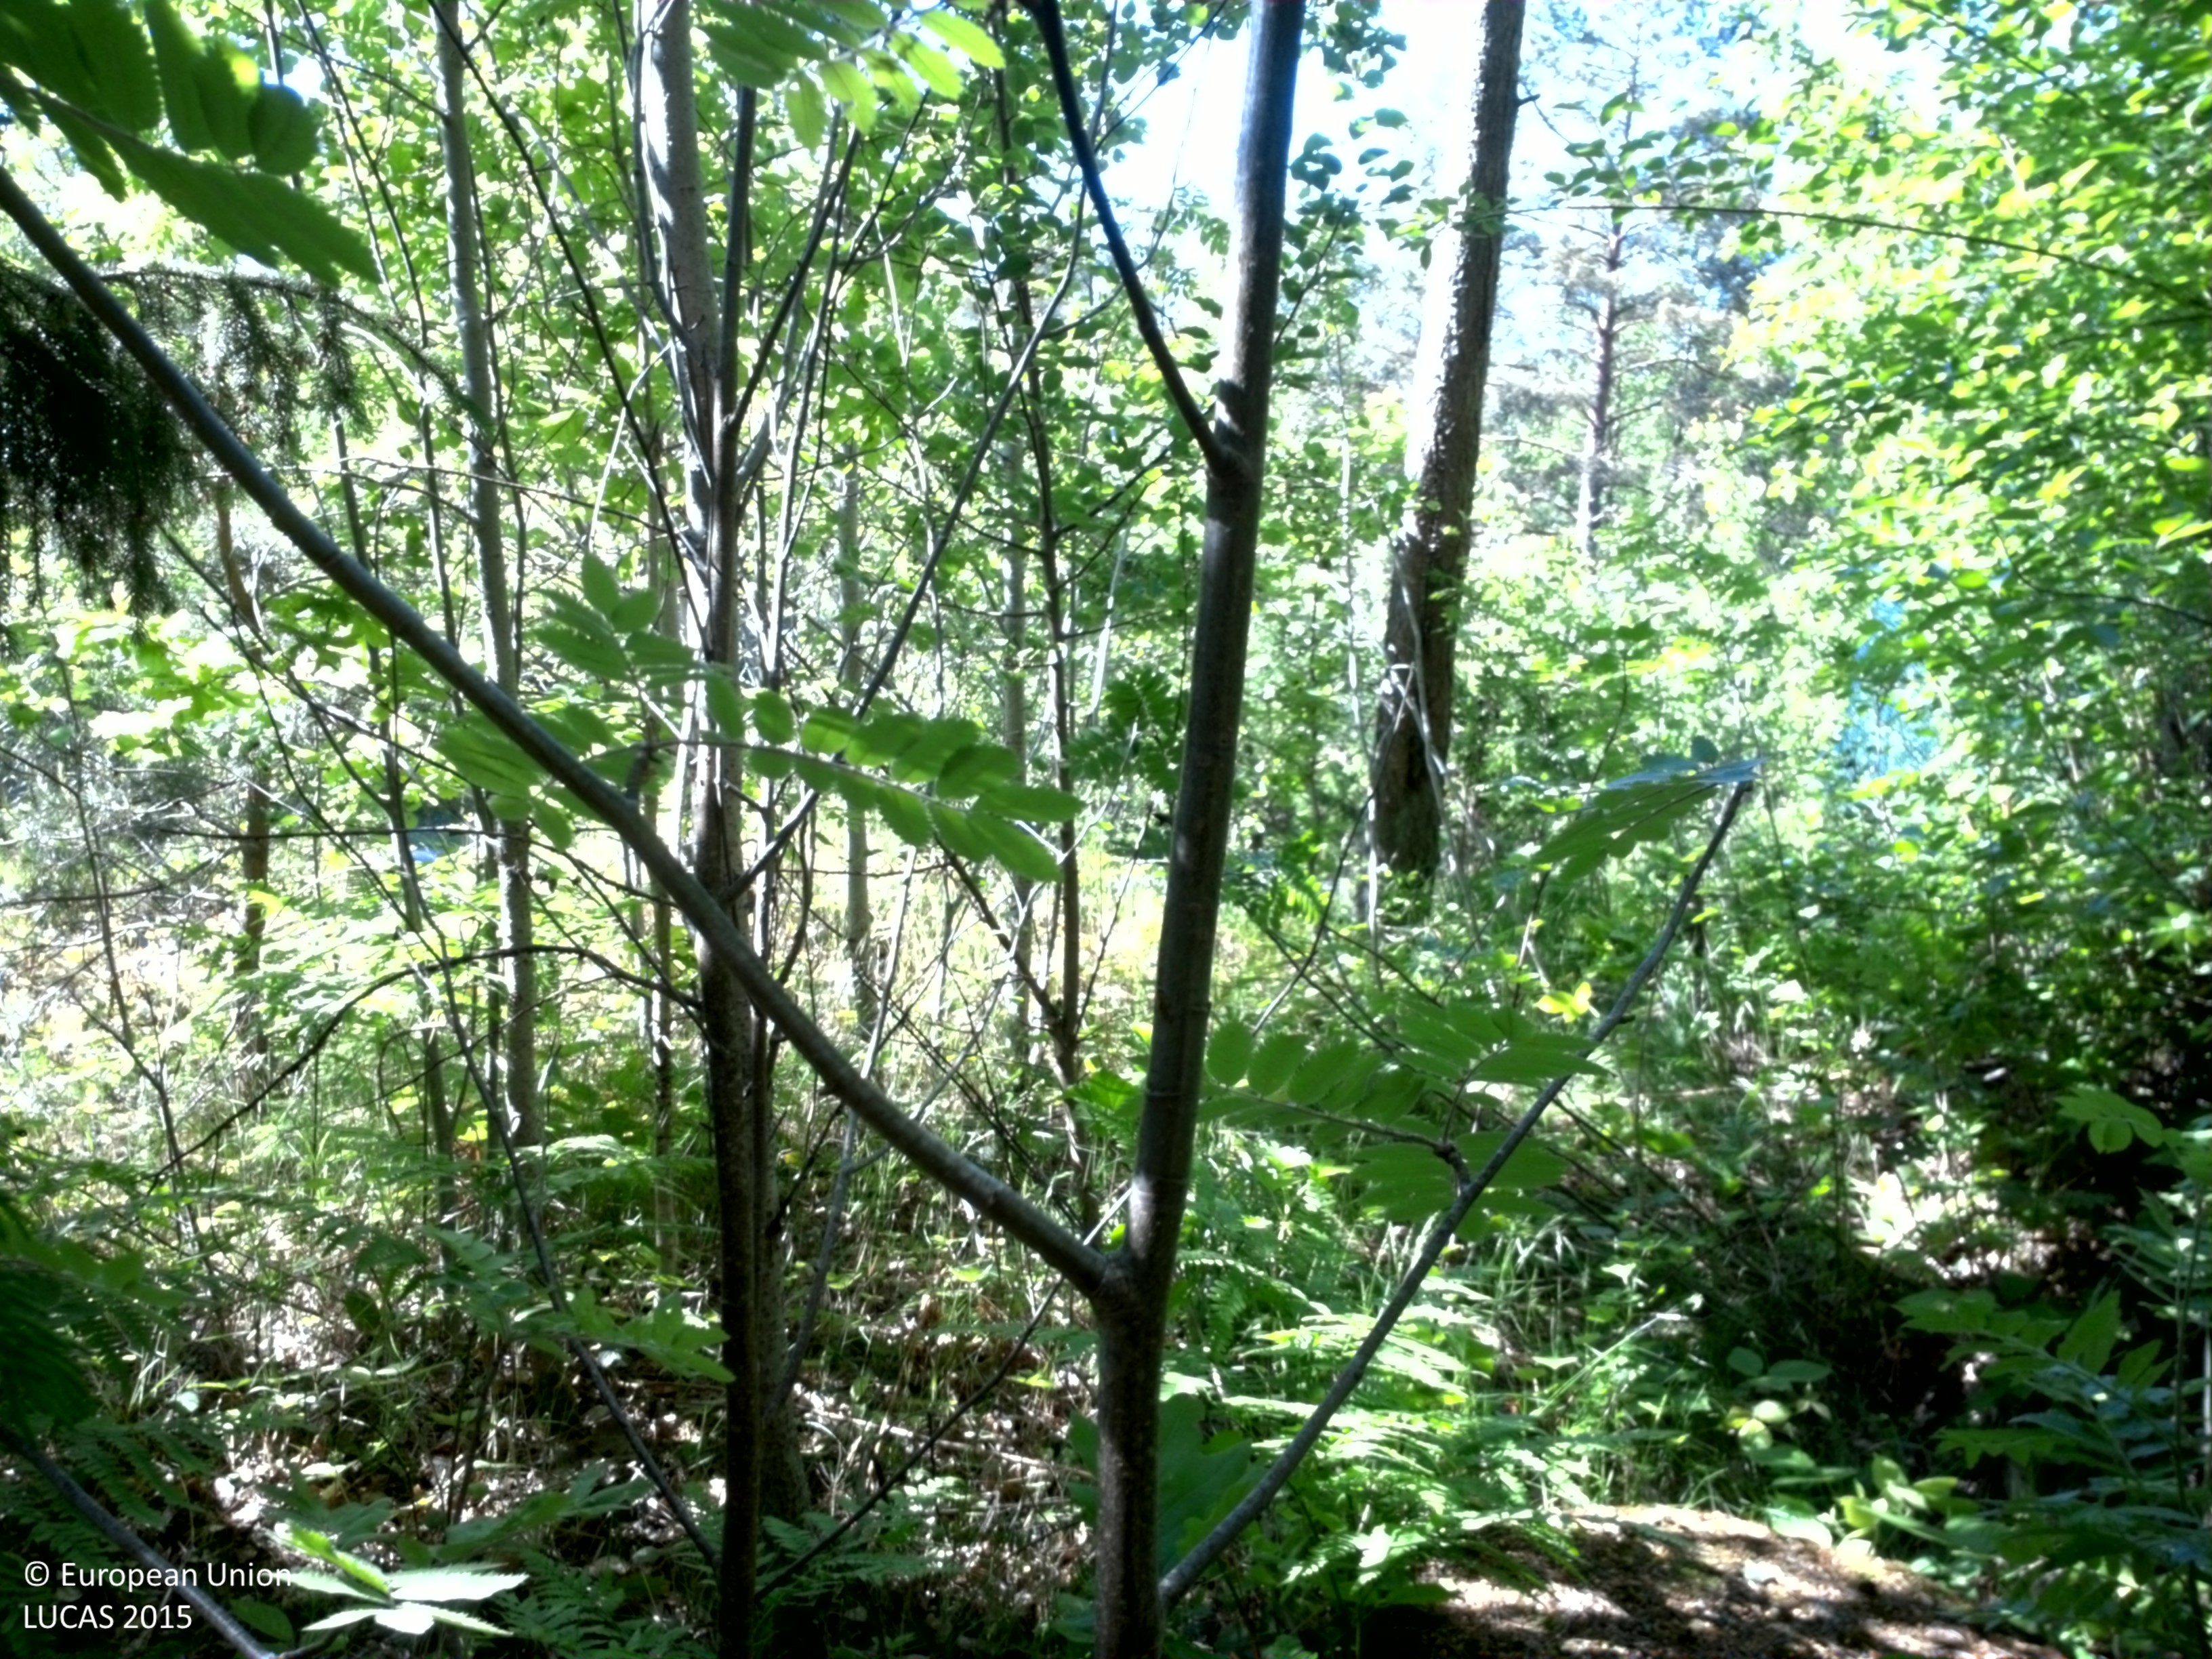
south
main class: Woodland
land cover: Spruce dominated mixed woodland
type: boreal forest
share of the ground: 50 - 75 %
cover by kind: coniferous forest trees 45 %, broadleaved forest trees 30 %, herbaceous plants 20 %, lichens and mosses 5 %
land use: Semi-natural and natural areas not in use
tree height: > 5 m
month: June
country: SE
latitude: 58.6600
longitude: 16.4596
